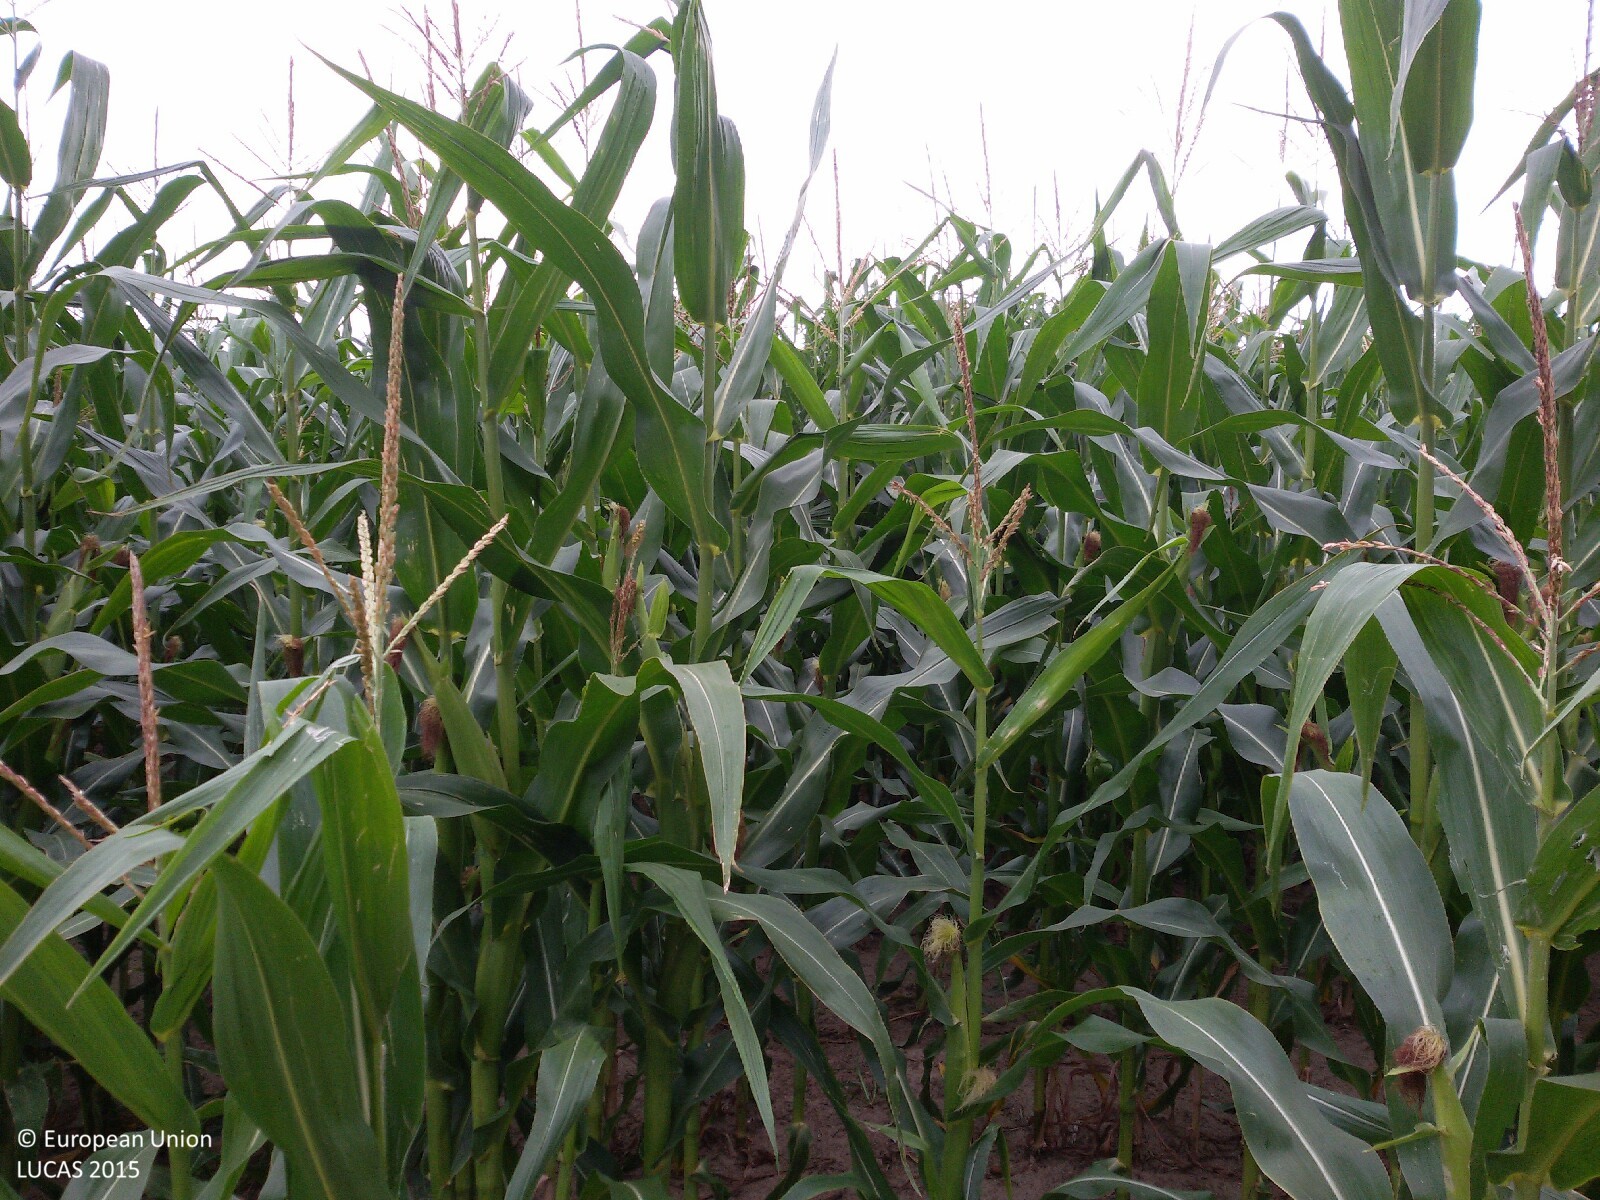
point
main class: Cropland
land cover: Maize
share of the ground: > 75 %
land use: Agriculture (excluding fallow land and kitchen gardens)
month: July
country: PL
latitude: 51.8499
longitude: 21.7115
